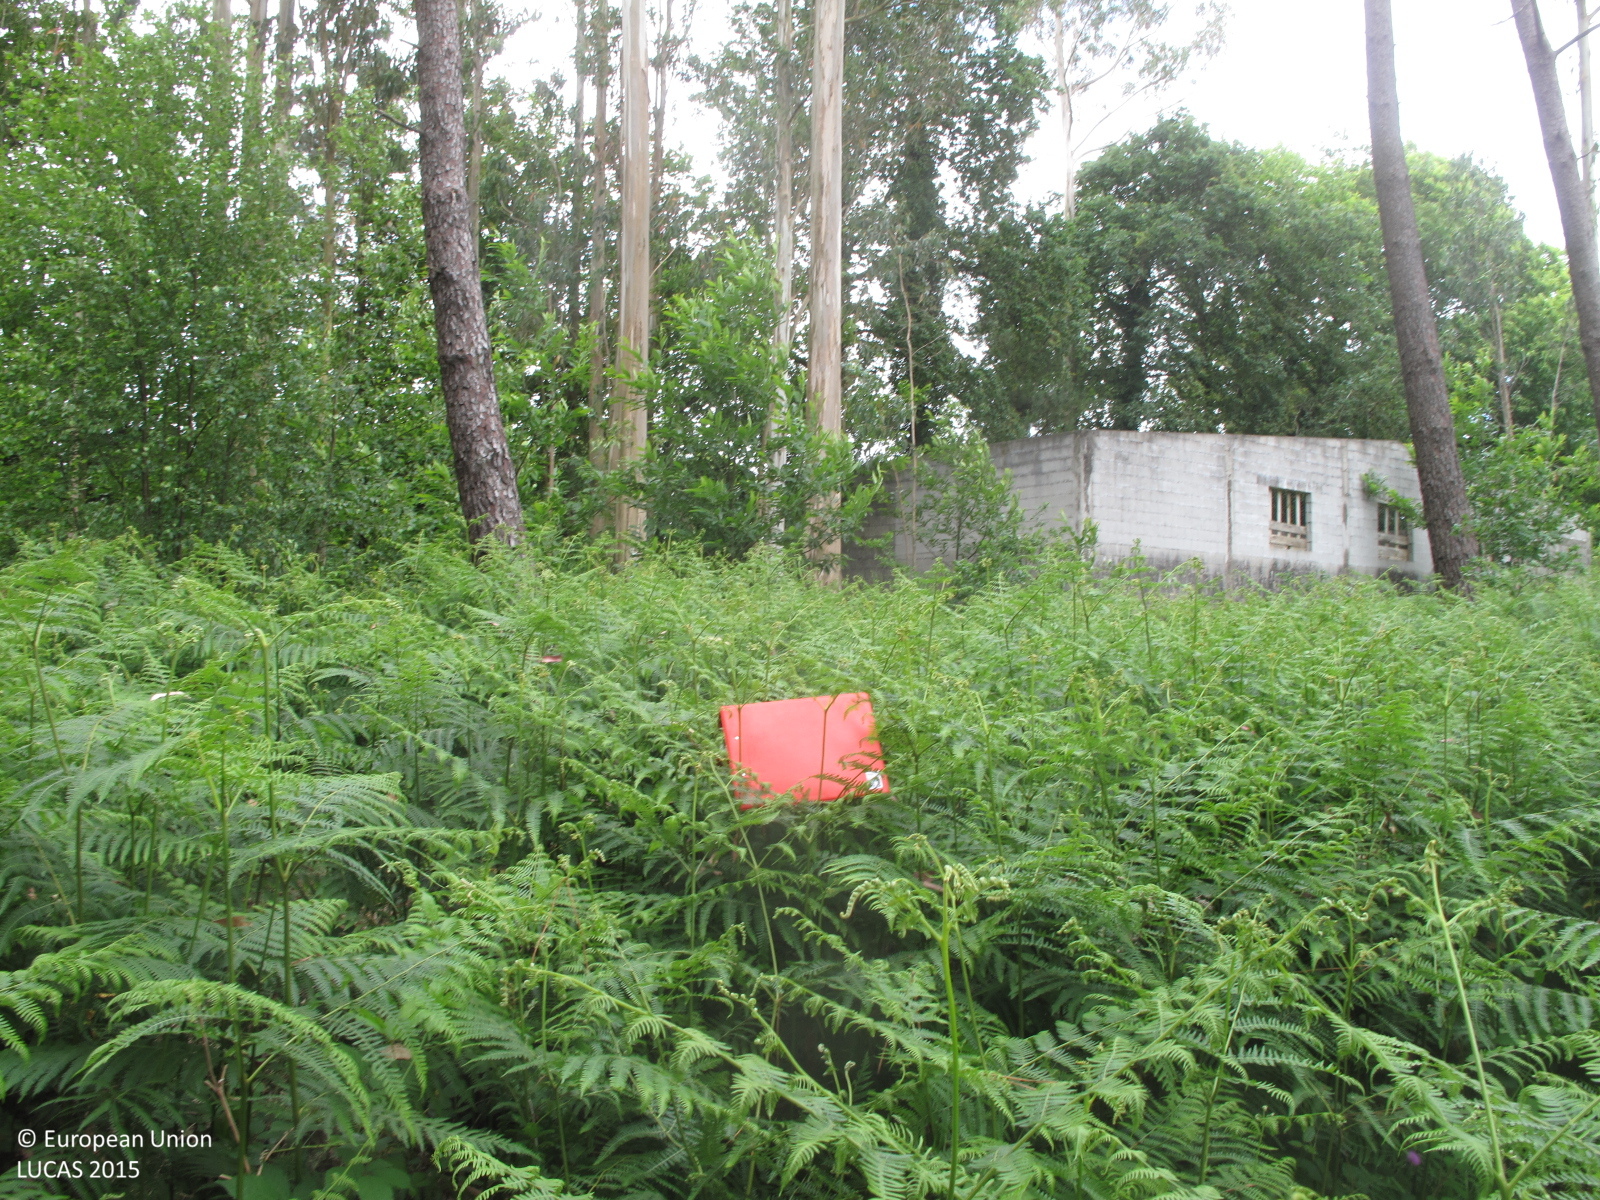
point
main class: Woodland
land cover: Other mixed woodland
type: exotic forest
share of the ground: > 75 %
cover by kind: broadleaved forest trees 40 %, coniferous forest trees 30 %, herbaceous plants 30 %
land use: Forestry
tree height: > 5 m
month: June
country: ES
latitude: 43.0506
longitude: -8.5343
